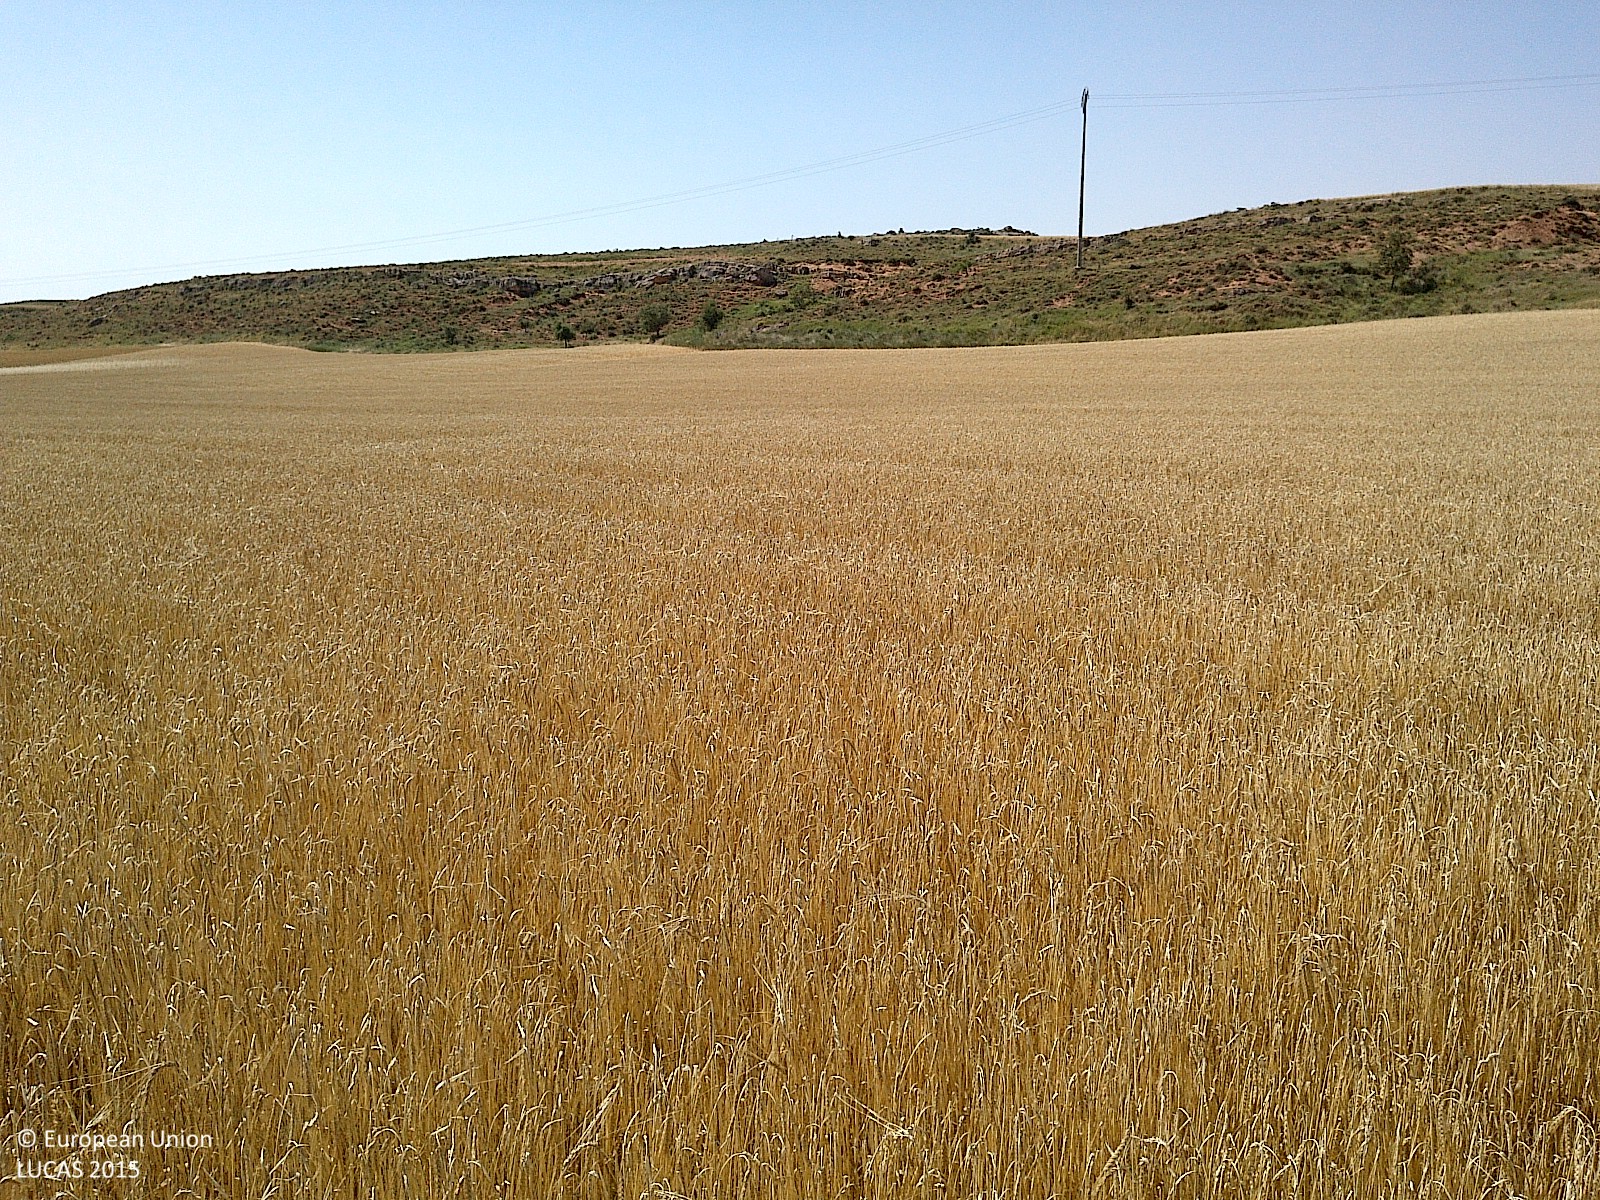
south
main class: Cropland
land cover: Barley
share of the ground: > 75 %
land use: Agriculture (excluding fallow land and kitchen gardens)
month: July
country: ES
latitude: 41.5721
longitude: -2.1573
